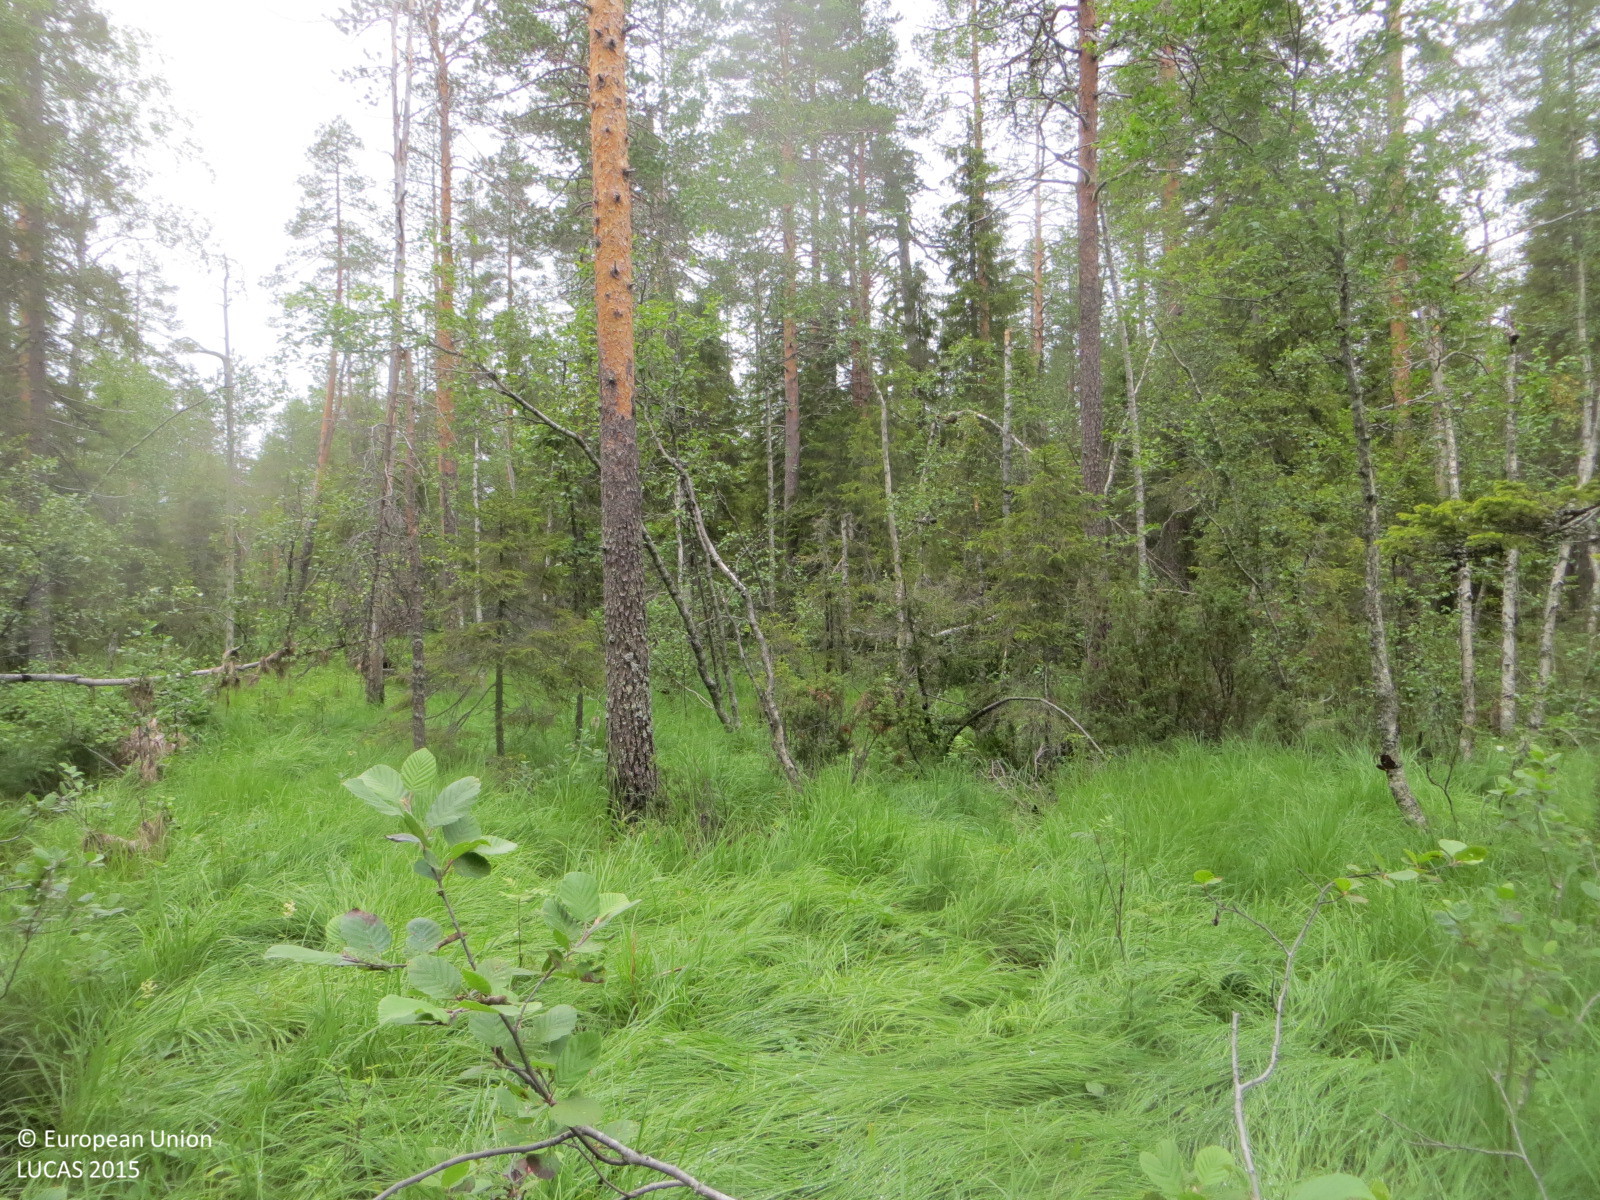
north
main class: Woodland
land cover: Other mixed woodland
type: boreal forest
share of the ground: 50 - 75 %
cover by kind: herbaceous plants 45 %, coniferous forest trees 30 %, broadleaved forest trees 25 %
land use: Semi-natural and natural areas not in use
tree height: > 5 m
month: July
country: FI
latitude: 66.2999
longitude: 24.8352
